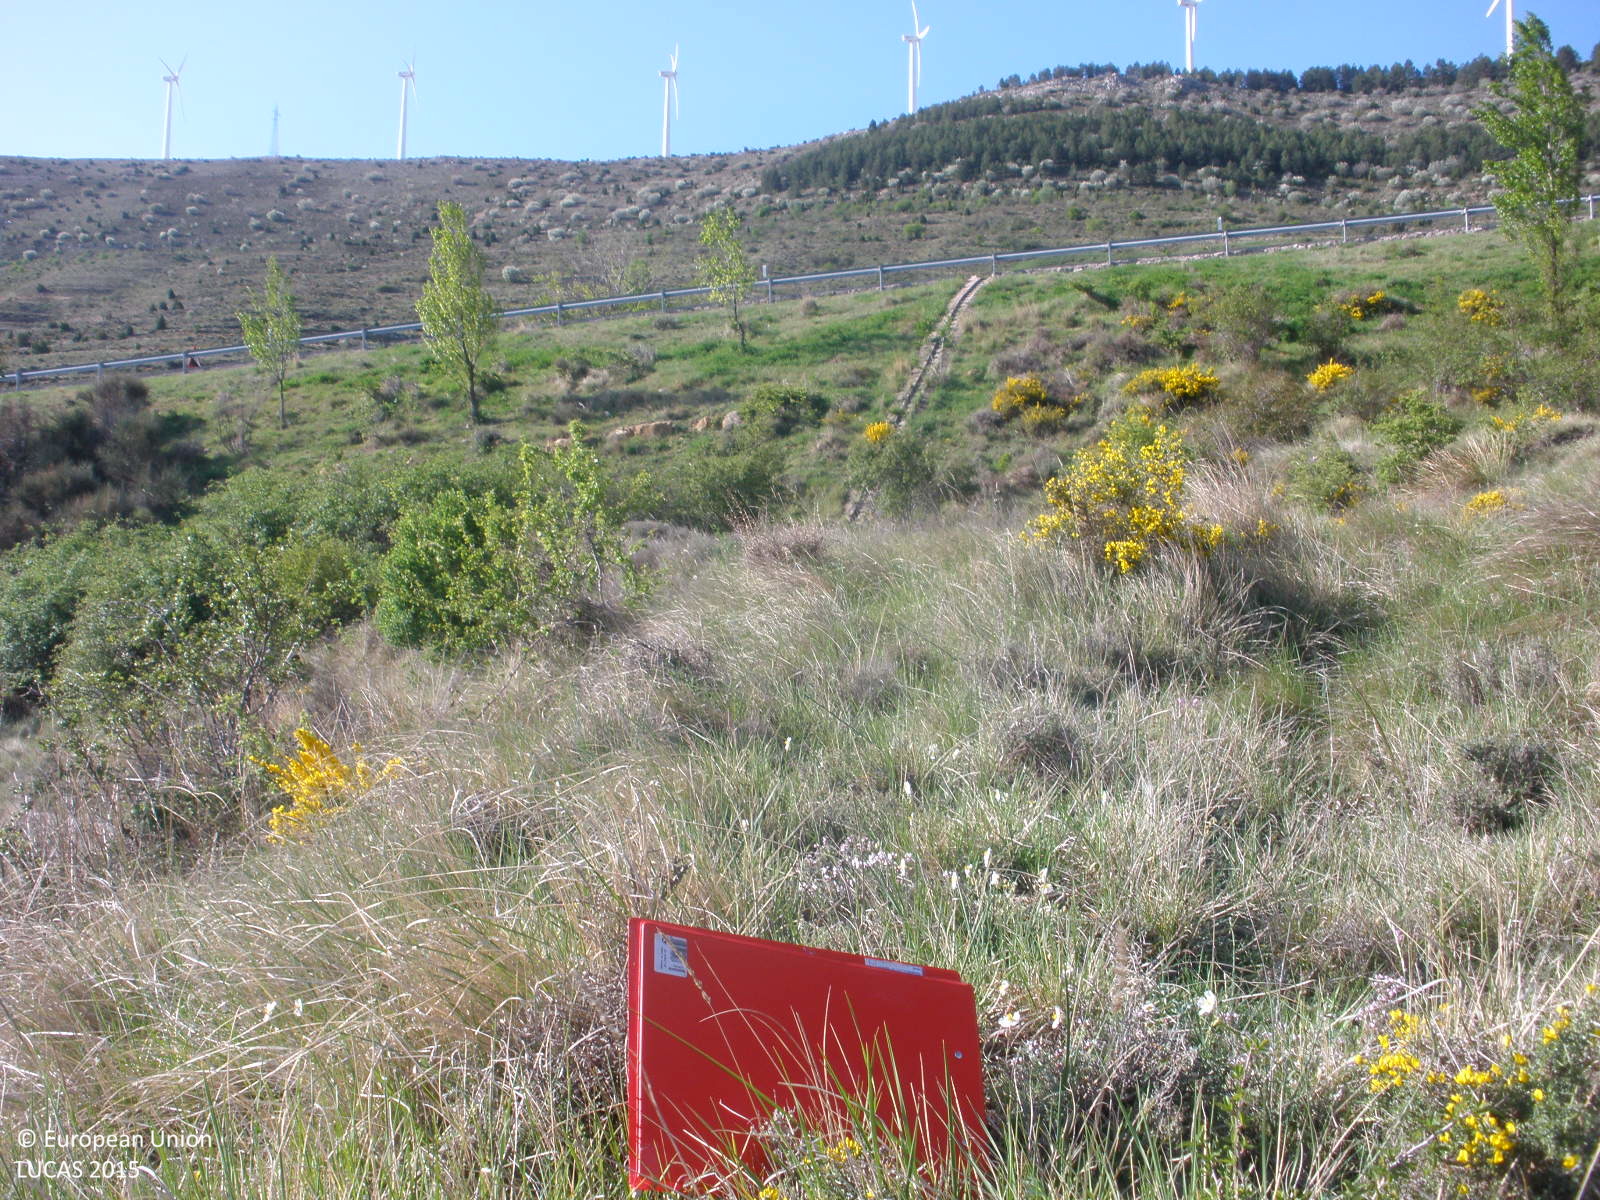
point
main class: Shrubland
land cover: Shrubland without tree cover
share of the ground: > 75 %
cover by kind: herbaceous plants 60 %, shrubs 40 %
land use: Semi-natural and natural areas not in use
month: May
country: ES
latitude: 40.7781
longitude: -0.8311
